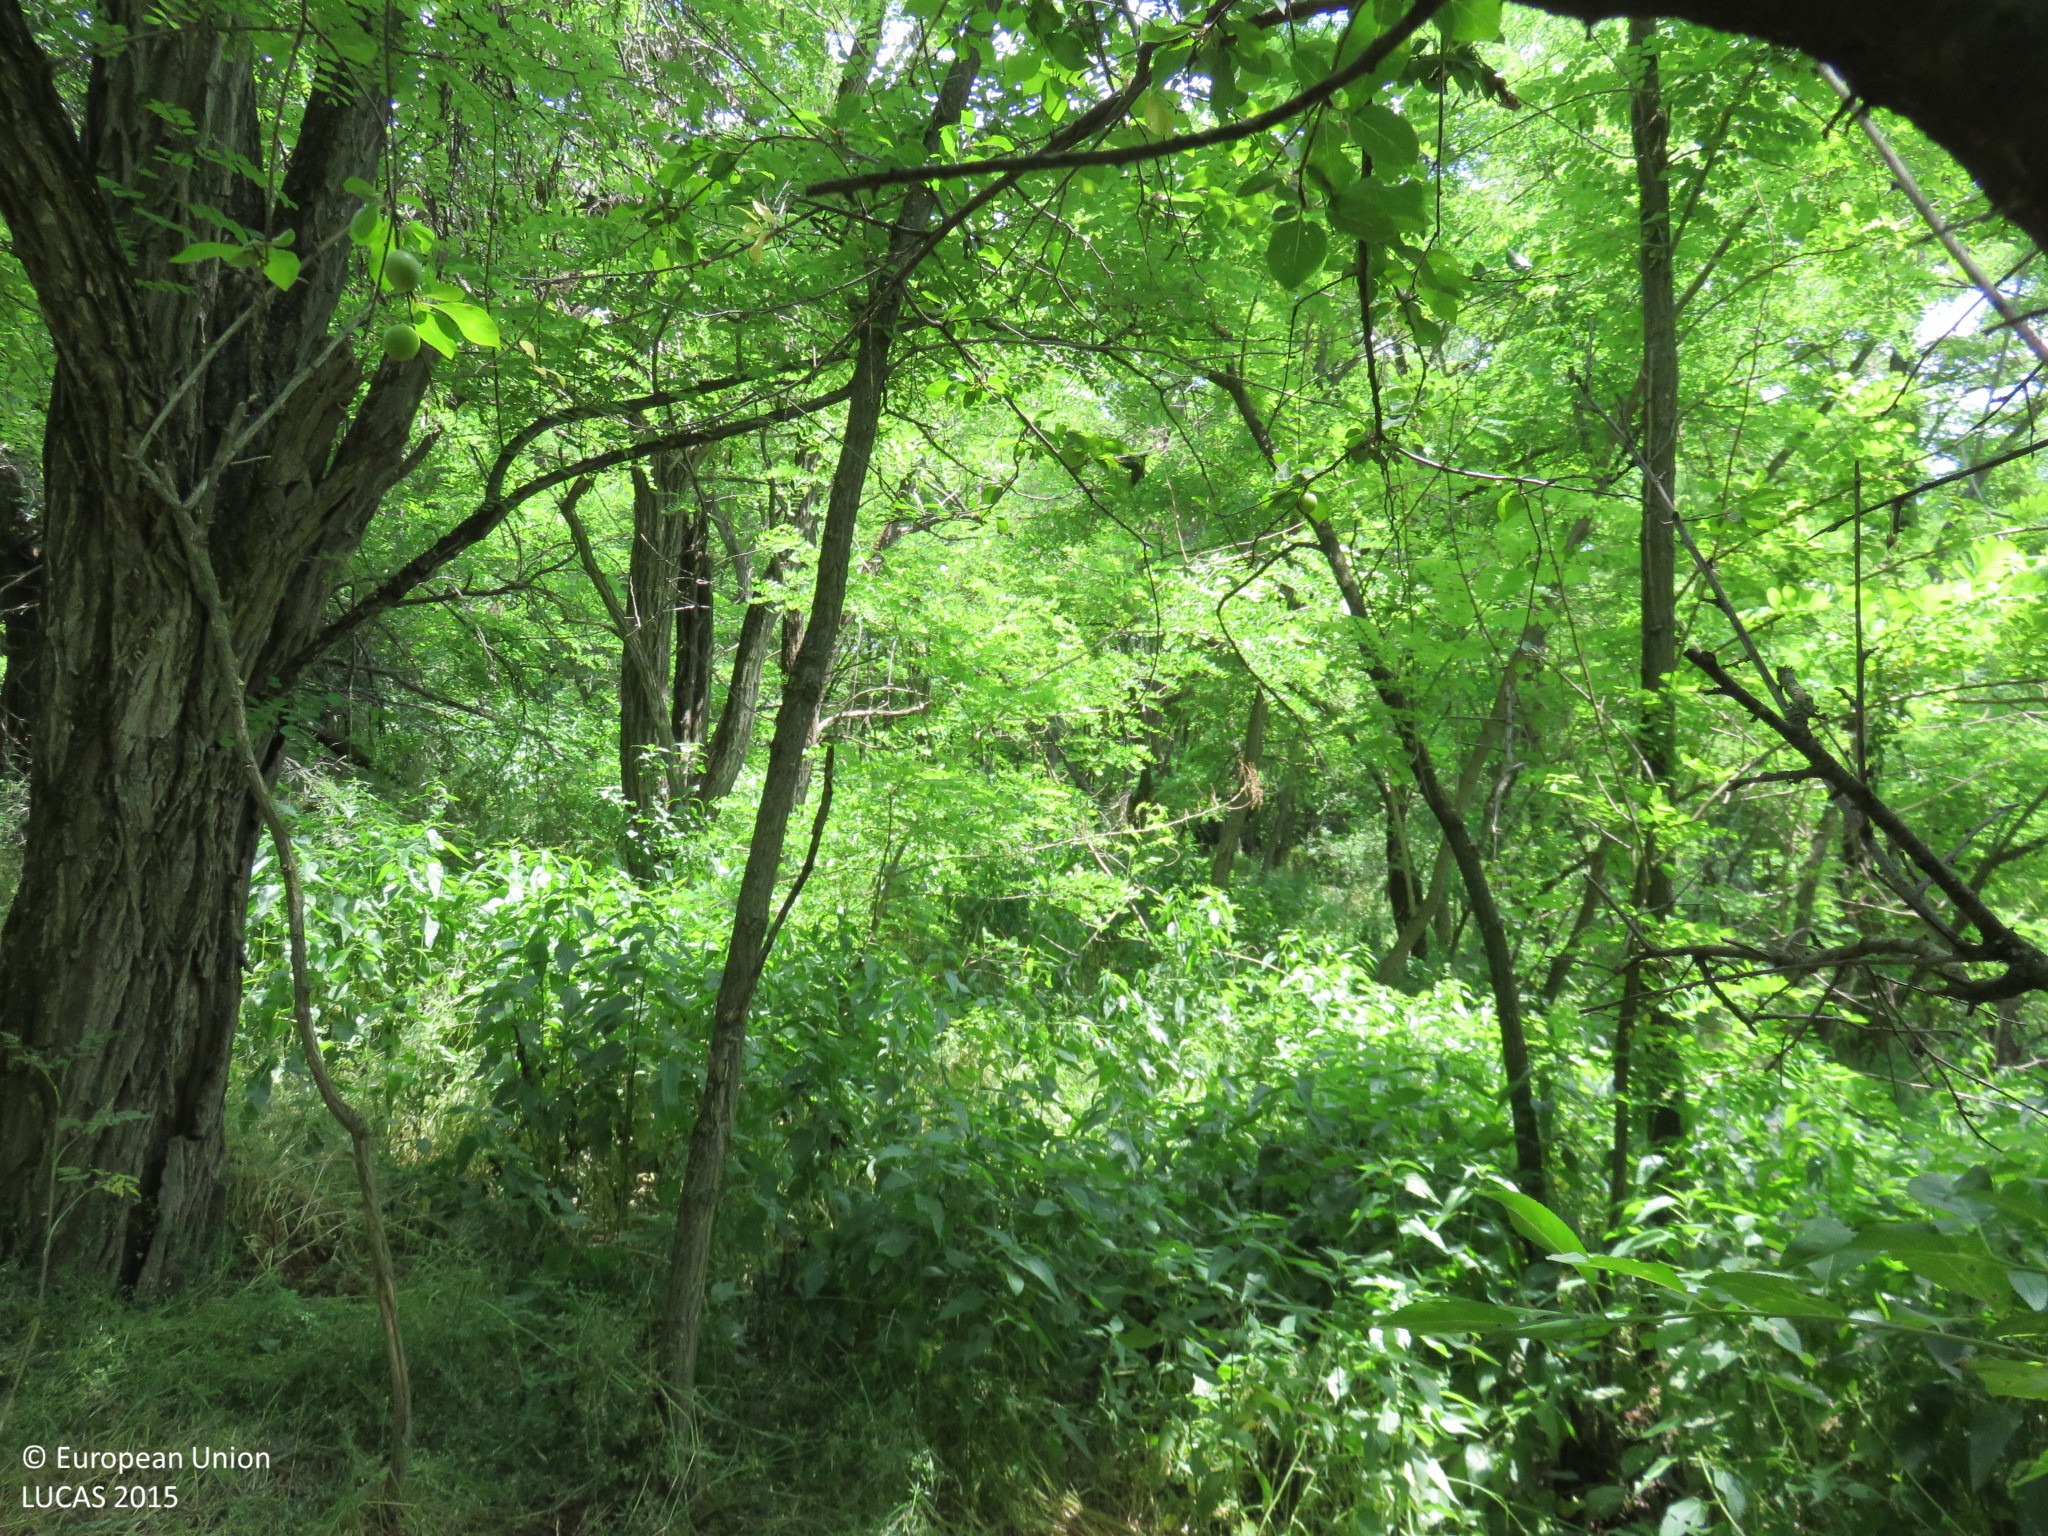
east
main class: Woodland
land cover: Broadleaved woodland
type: mesophytic deciduous forest
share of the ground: > 75 %
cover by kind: broadleaved forest trees 80 %, shrubs 10 %, herbaceous plants 10 %
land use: Forestry
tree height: < 5 m
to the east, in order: Broadleaved woodland; Shrubland with sparse tree cover; Broadleaved woodland; Shrubland without tree cover
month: June
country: BG
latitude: 43.2761
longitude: 24.4631
